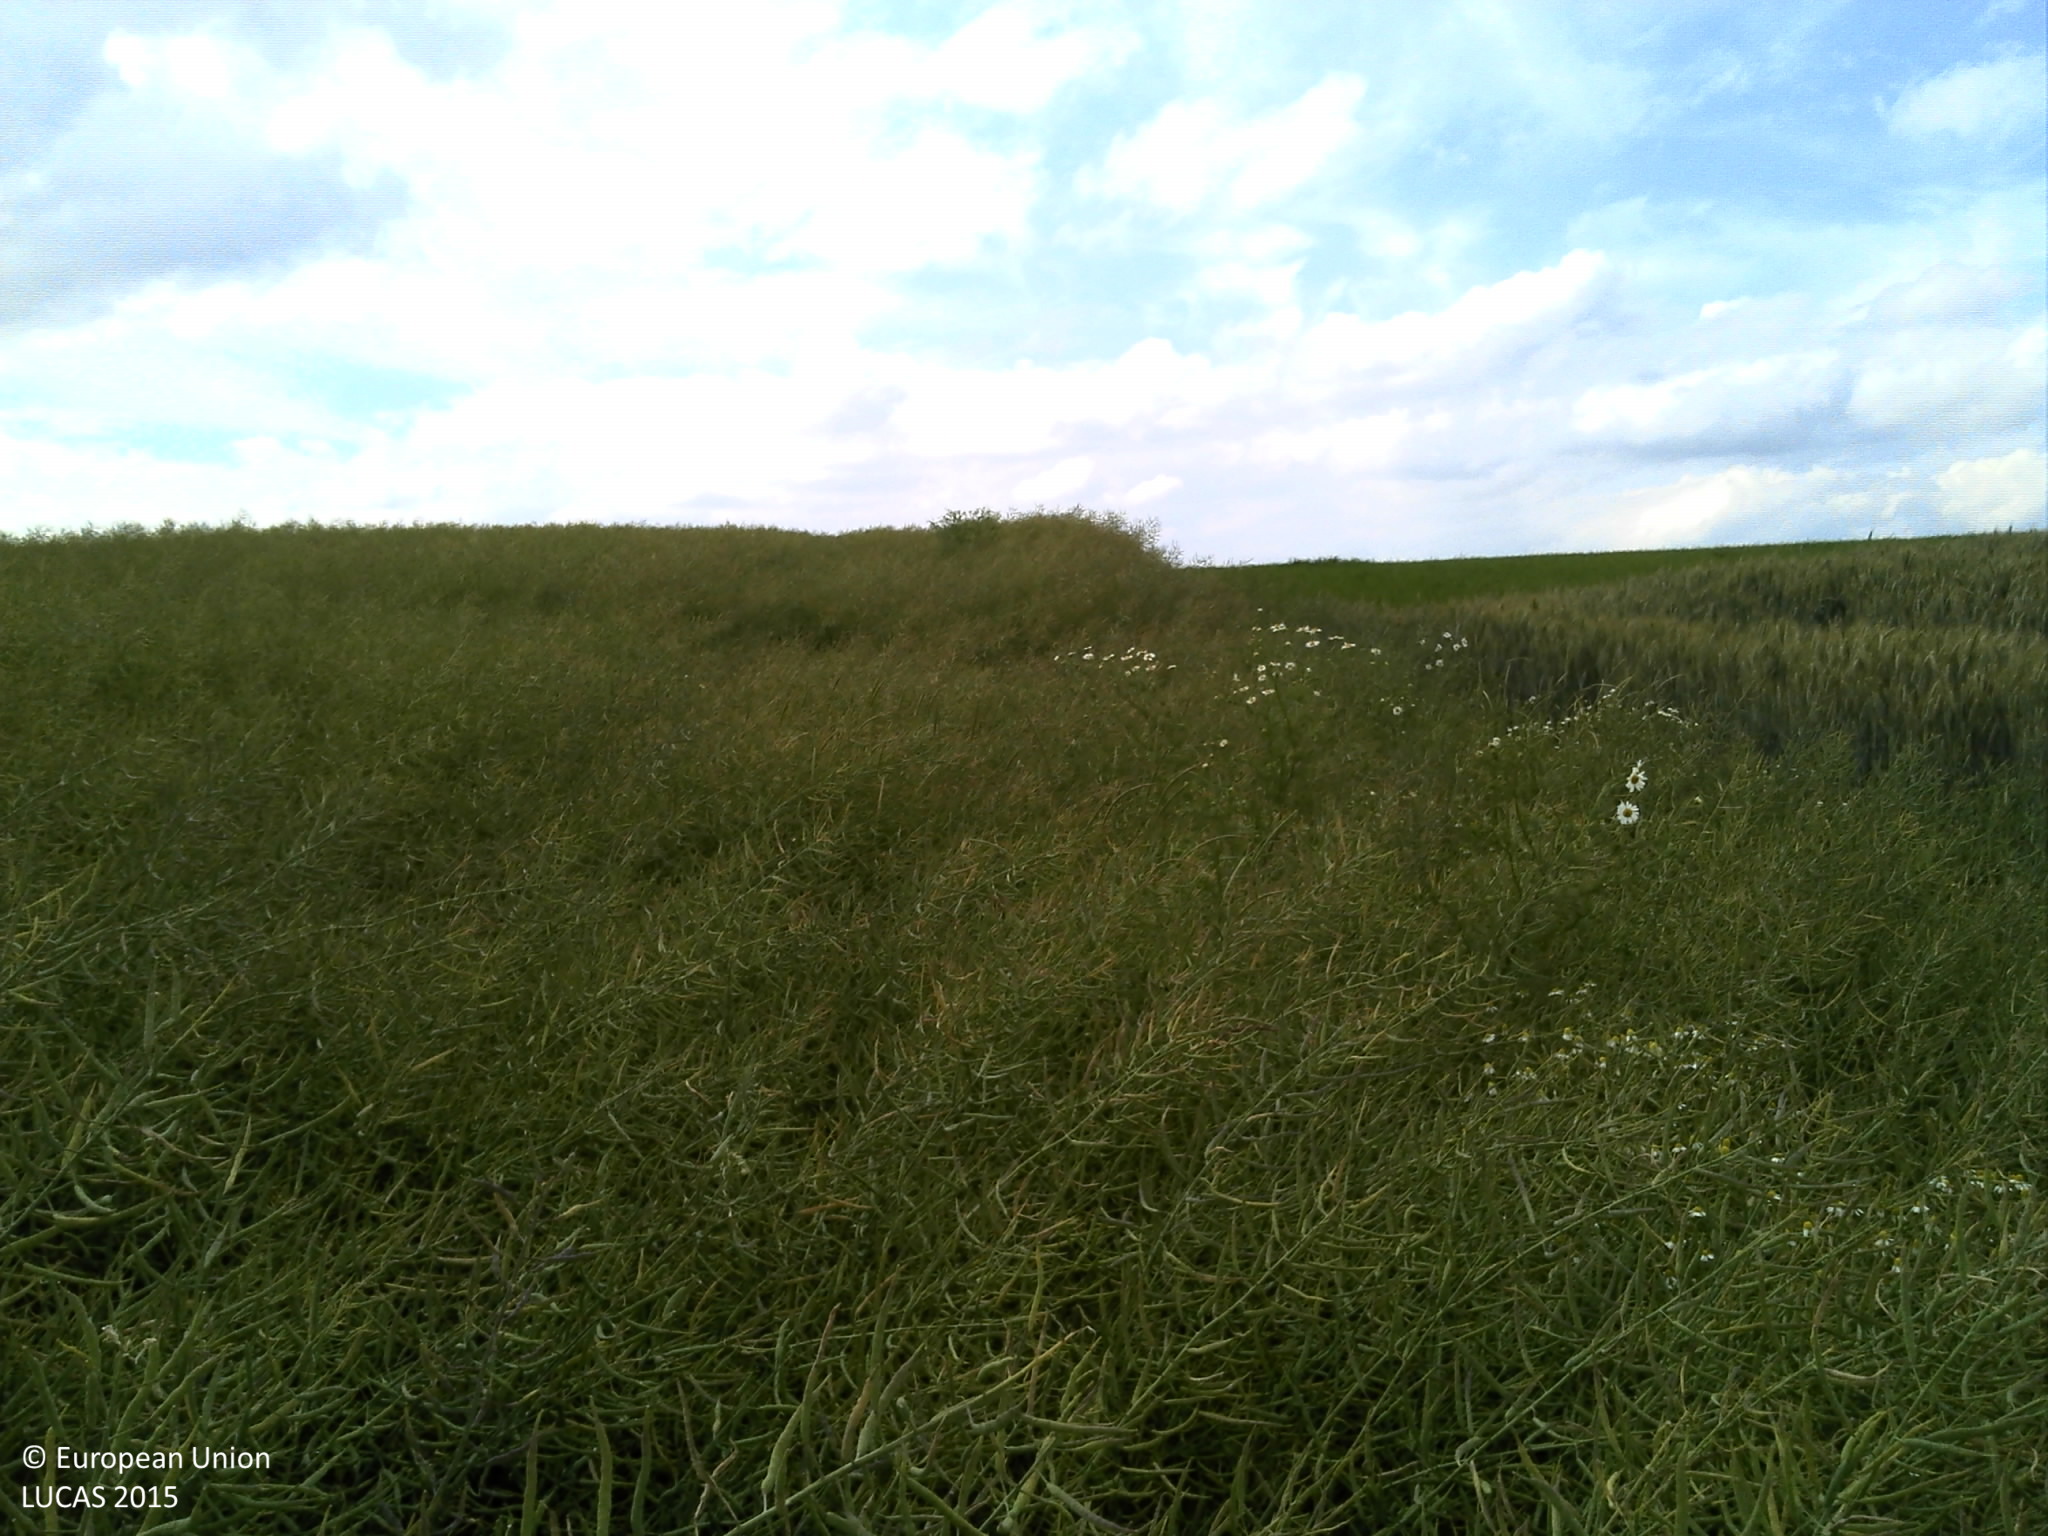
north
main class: Cropland
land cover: Rape and turnip rape
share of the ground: > 75 %
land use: Agriculture (excluding fallow land and kitchen gardens)
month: June
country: FR
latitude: 49.4448
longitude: 5.0185
